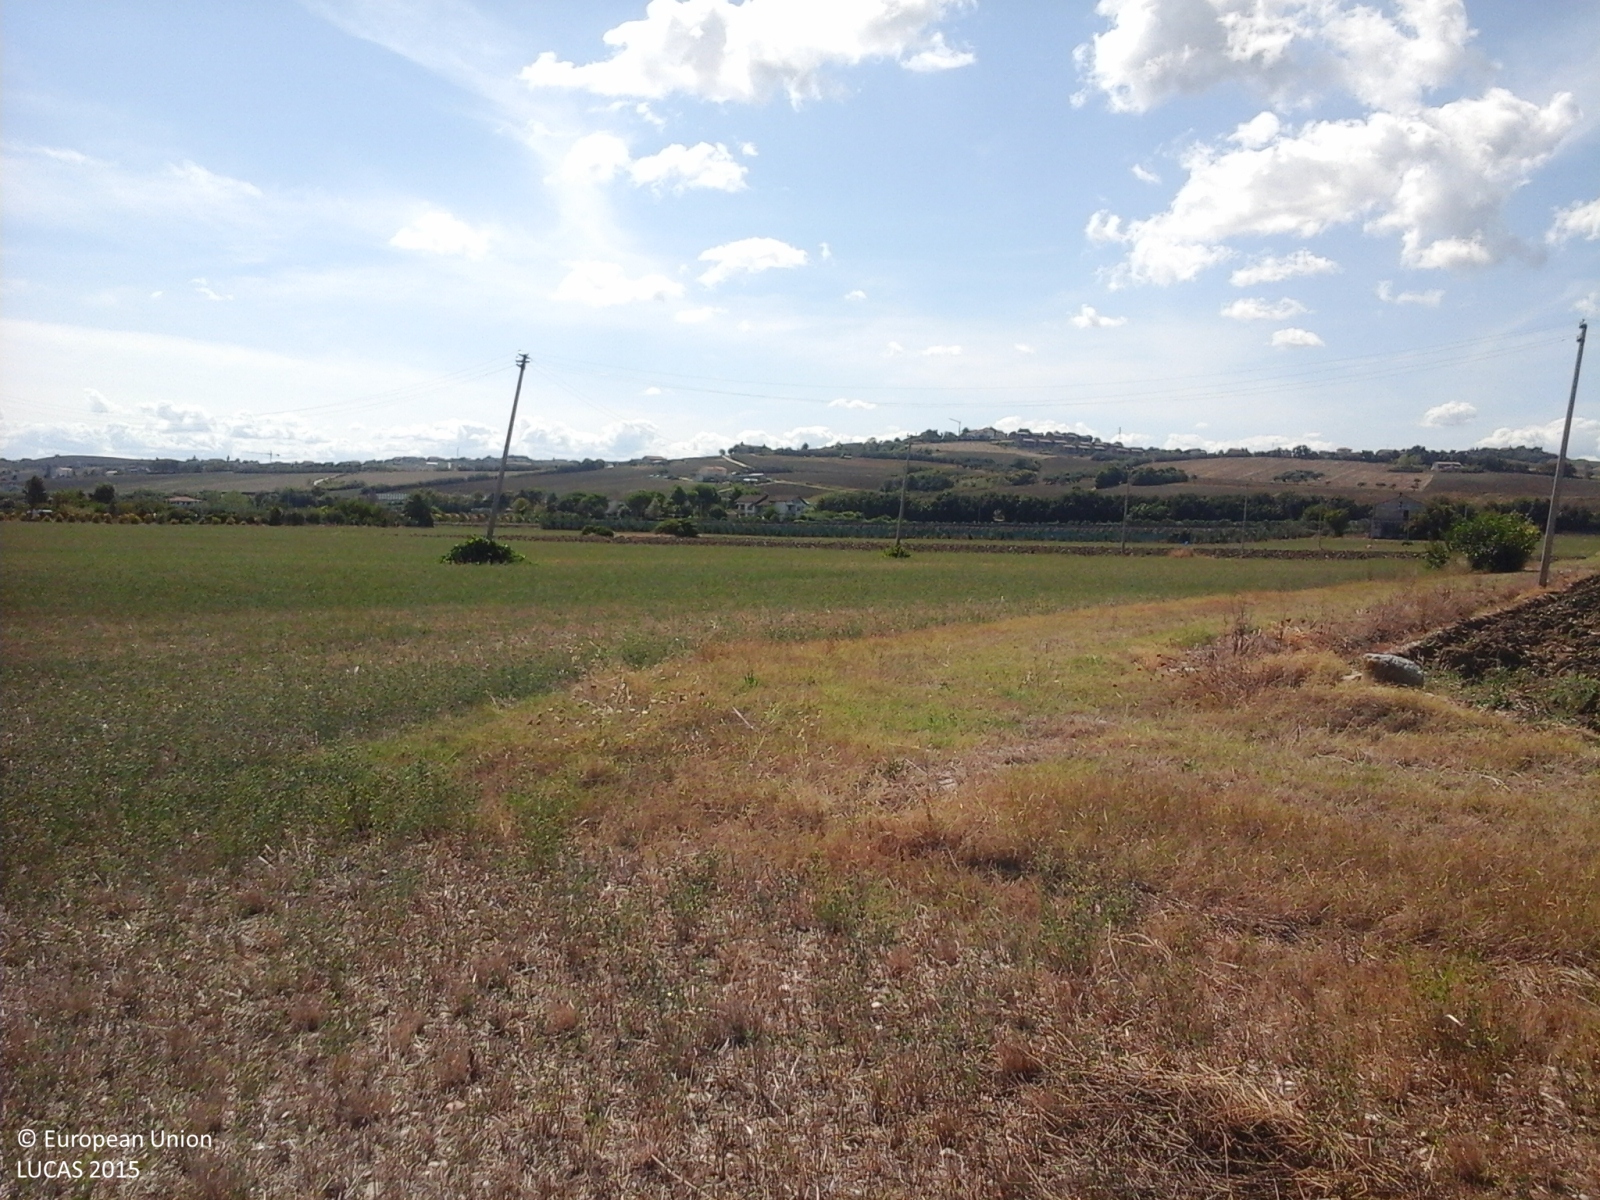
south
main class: Cropland
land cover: Lucerne
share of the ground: > 75 %
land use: Agriculture (excluding fallow land and kitchen gardens)
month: September
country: IT
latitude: 43.7992
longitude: 13.0876
